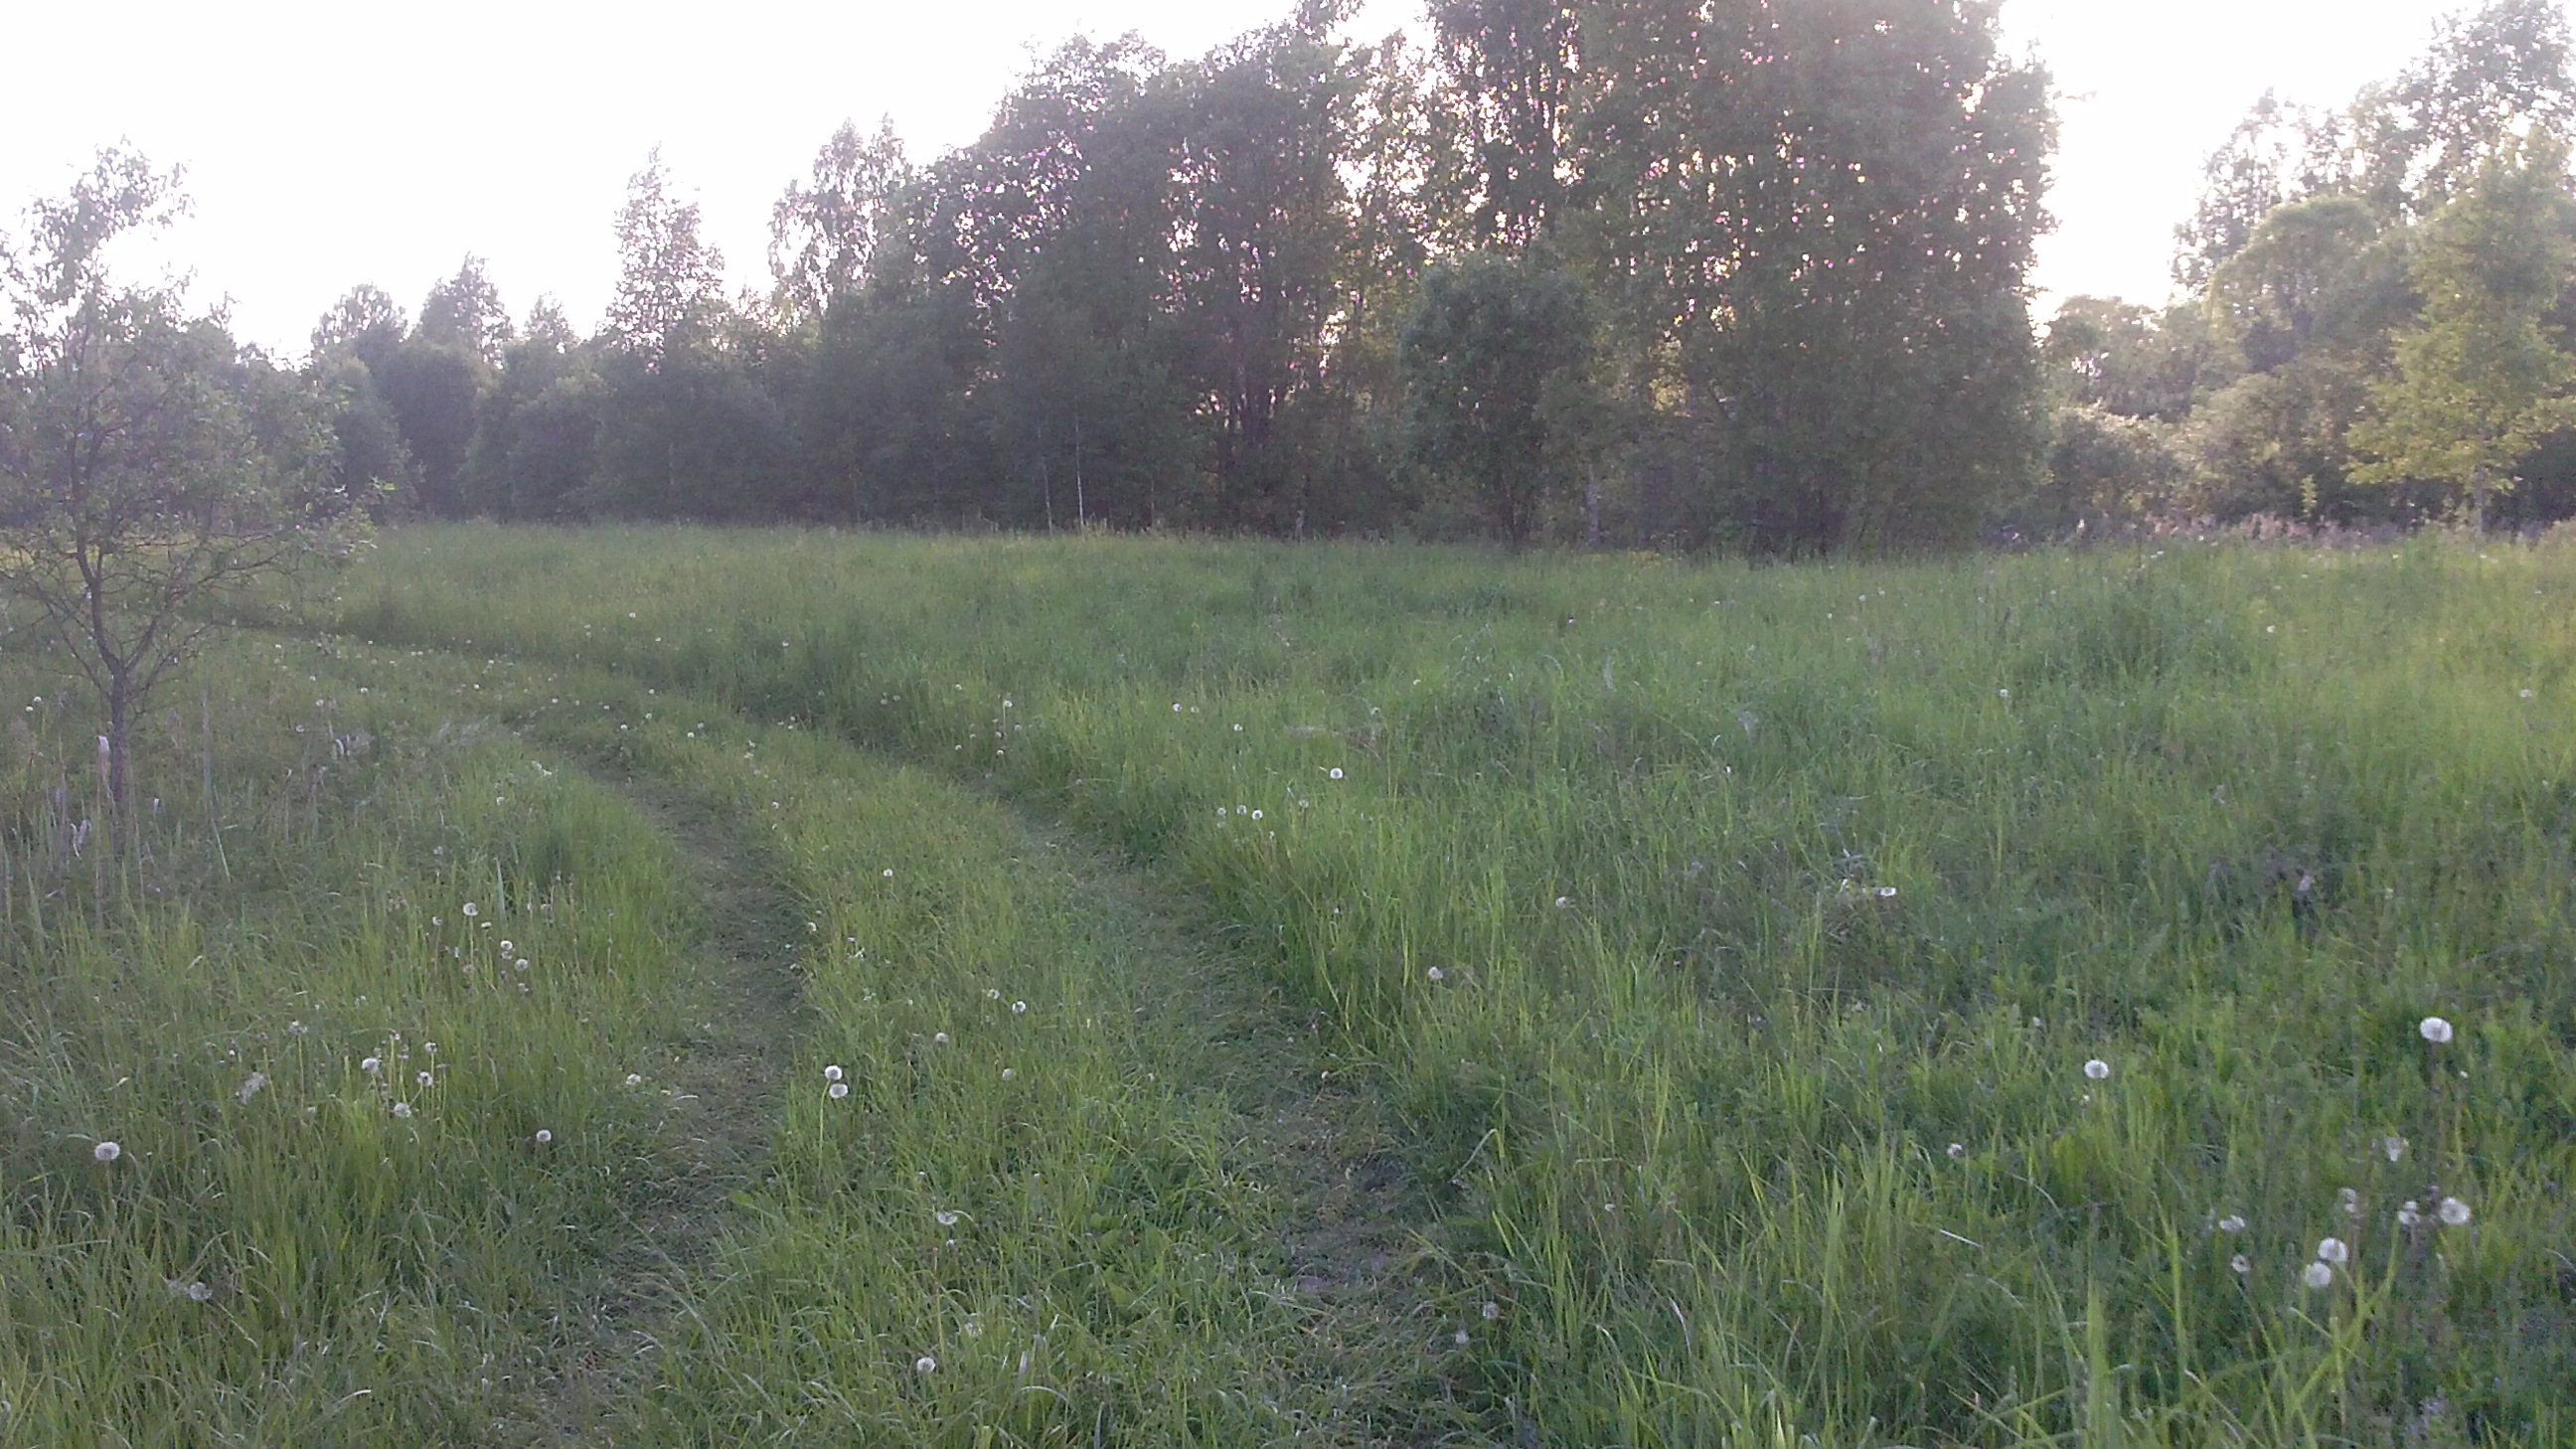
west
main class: Grassland
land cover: Grassland with sparse tree/shrub cover
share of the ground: > 75 %
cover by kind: herbaceous plants 95 %, broadleaved forest trees 5 %
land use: Agriculture (excluding fallow land and kitchen gardens)
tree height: > 5 m
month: June
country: LV
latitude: 56.3479
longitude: 27.9454
